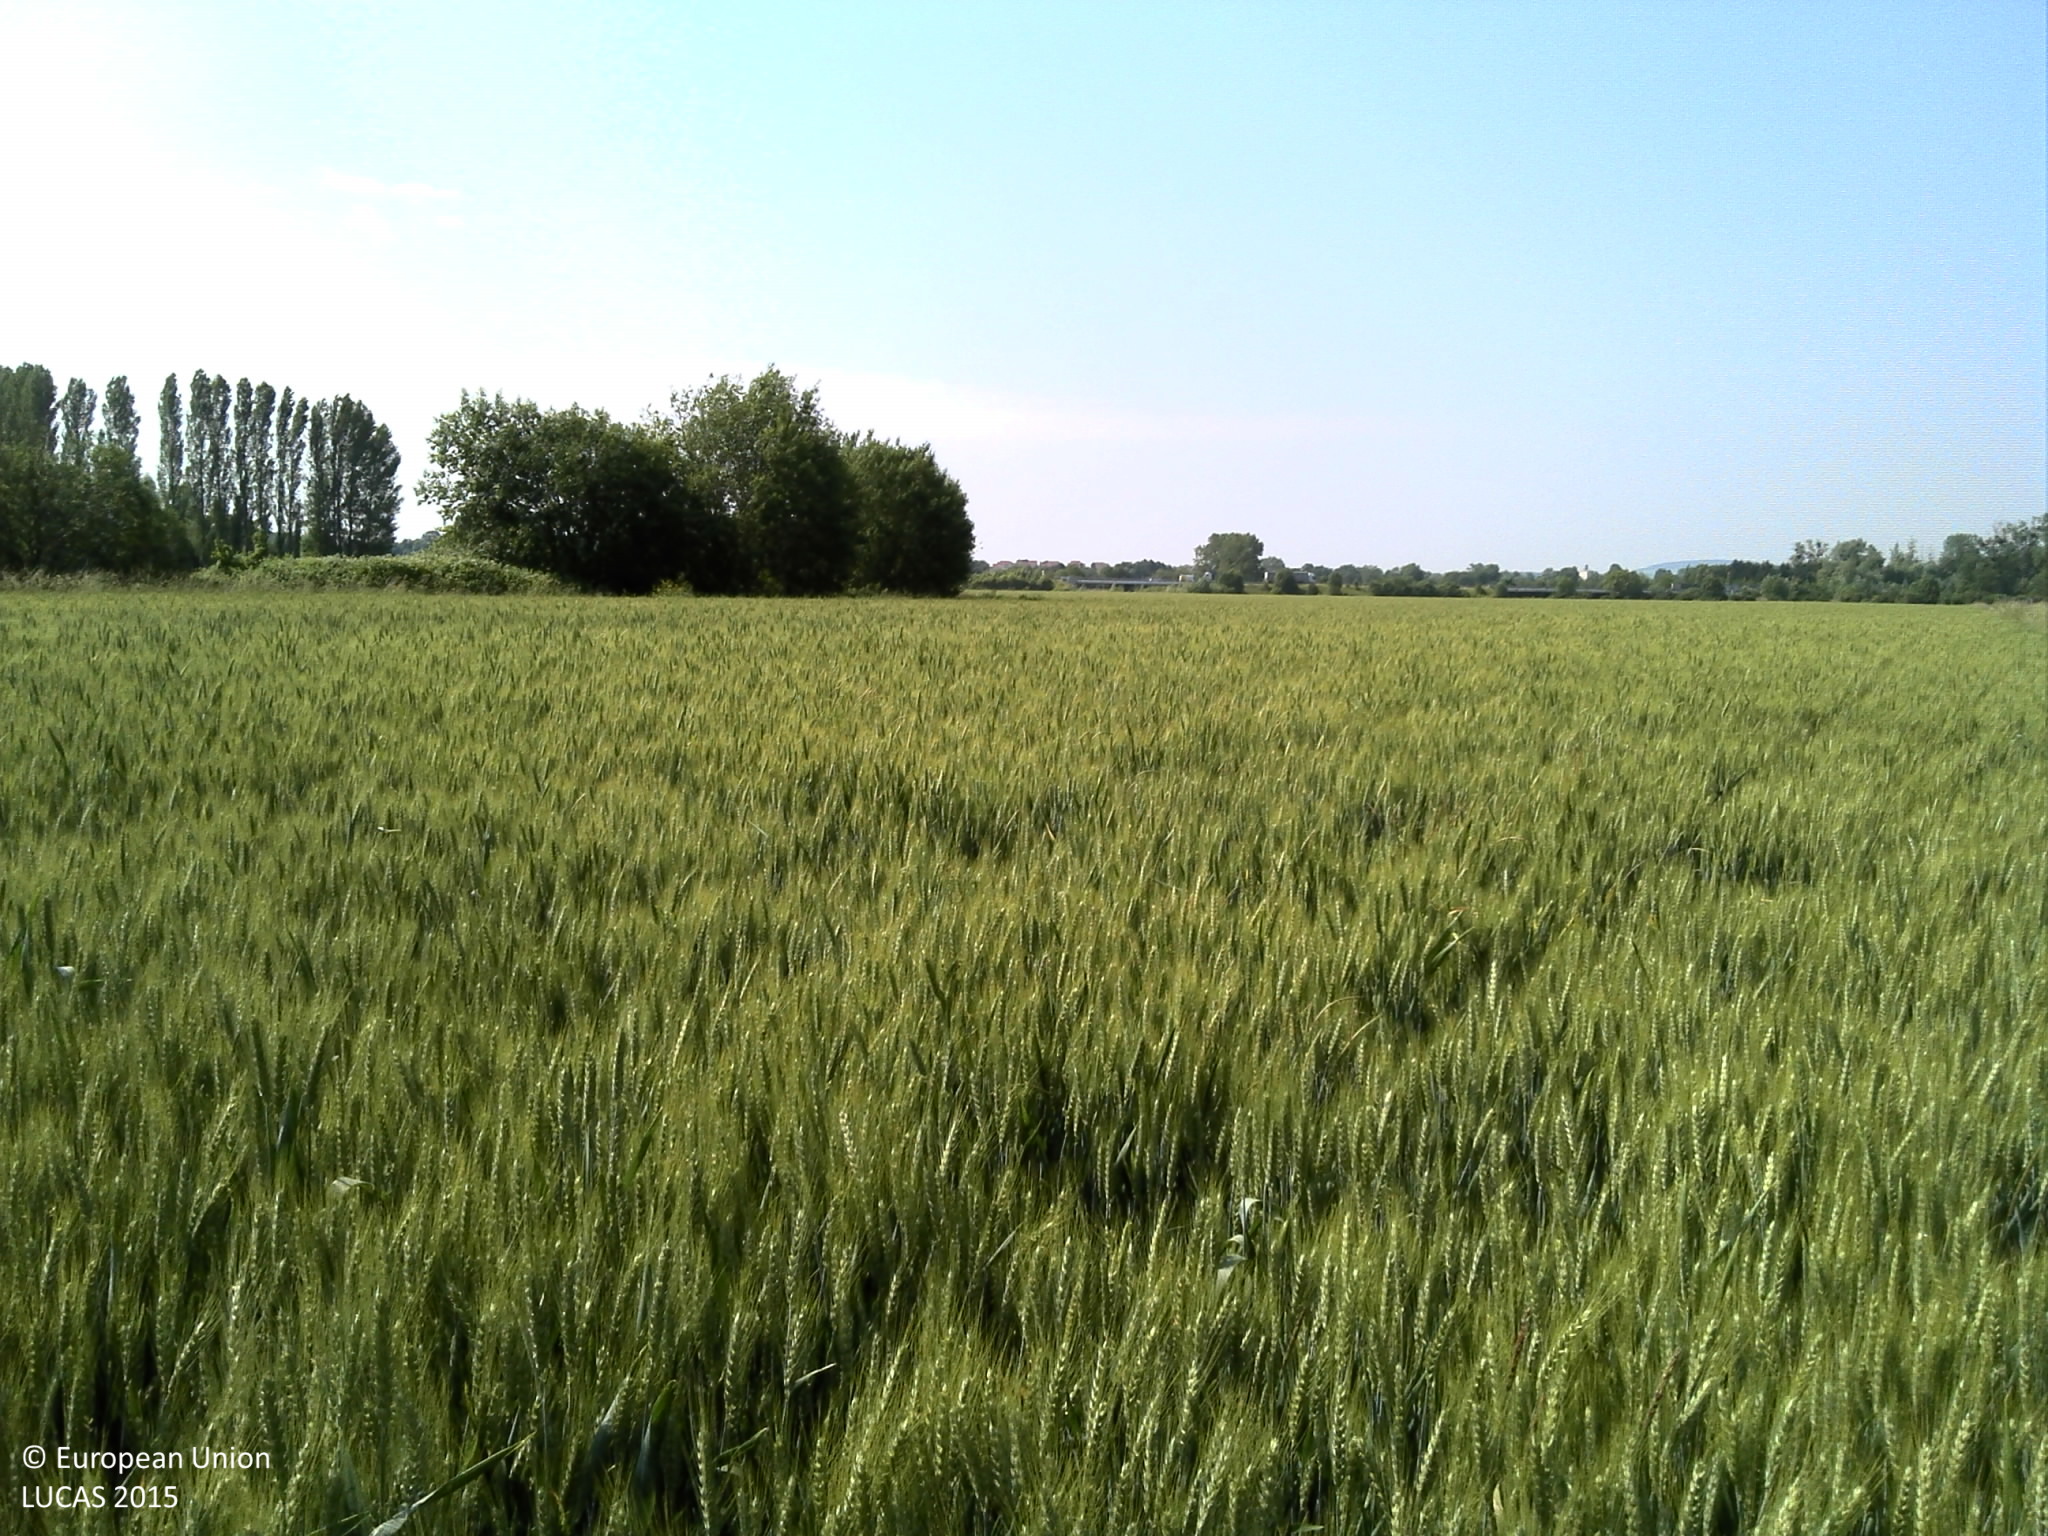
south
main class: Cropland
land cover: Common wheat
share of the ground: > 75 %
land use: Agriculture (excluding fallow land and kitchen gardens)
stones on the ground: < 10 %
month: June
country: FR
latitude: 49.0571
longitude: 6.1544
